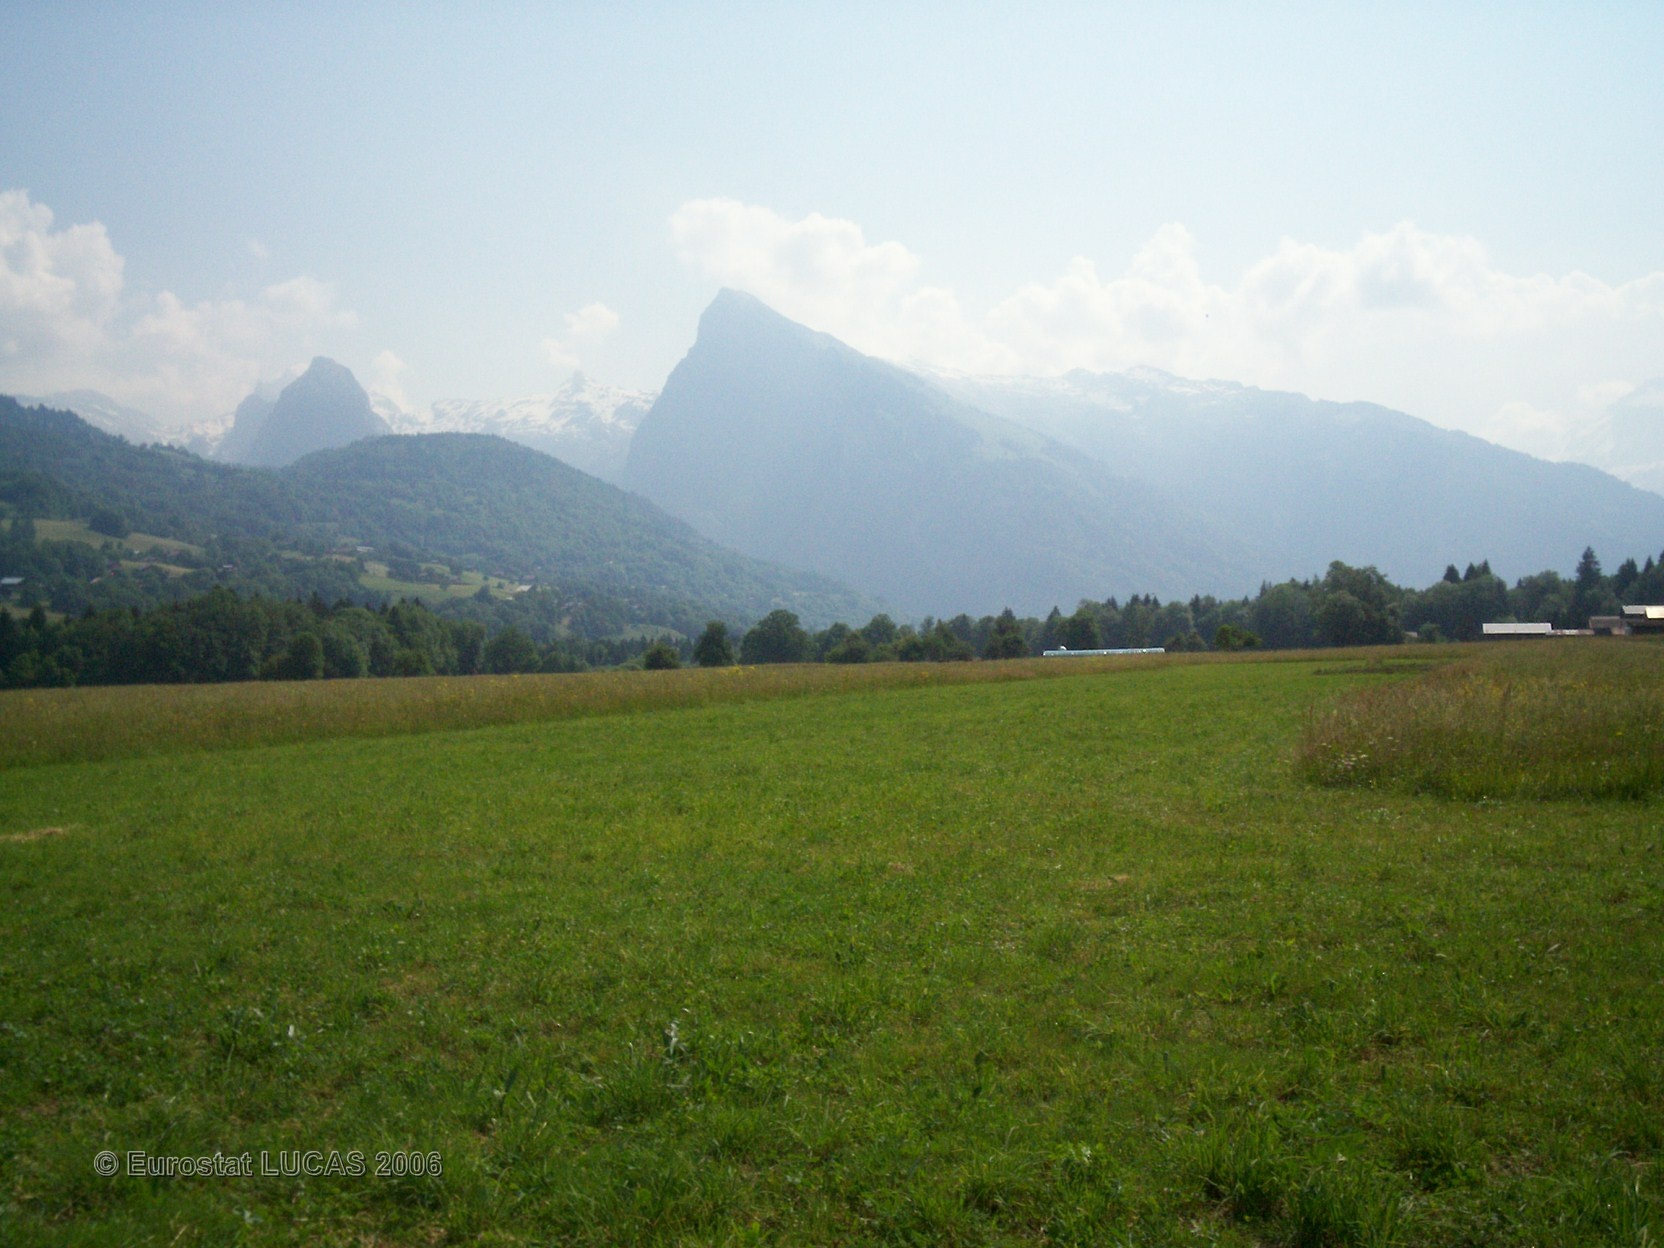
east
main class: Grassland
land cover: Grassland without tree/shrub cover
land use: Agriculture (excluding fallow land and kitchen gardens)
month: June
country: FR
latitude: 46.0834
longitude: 6.6801
